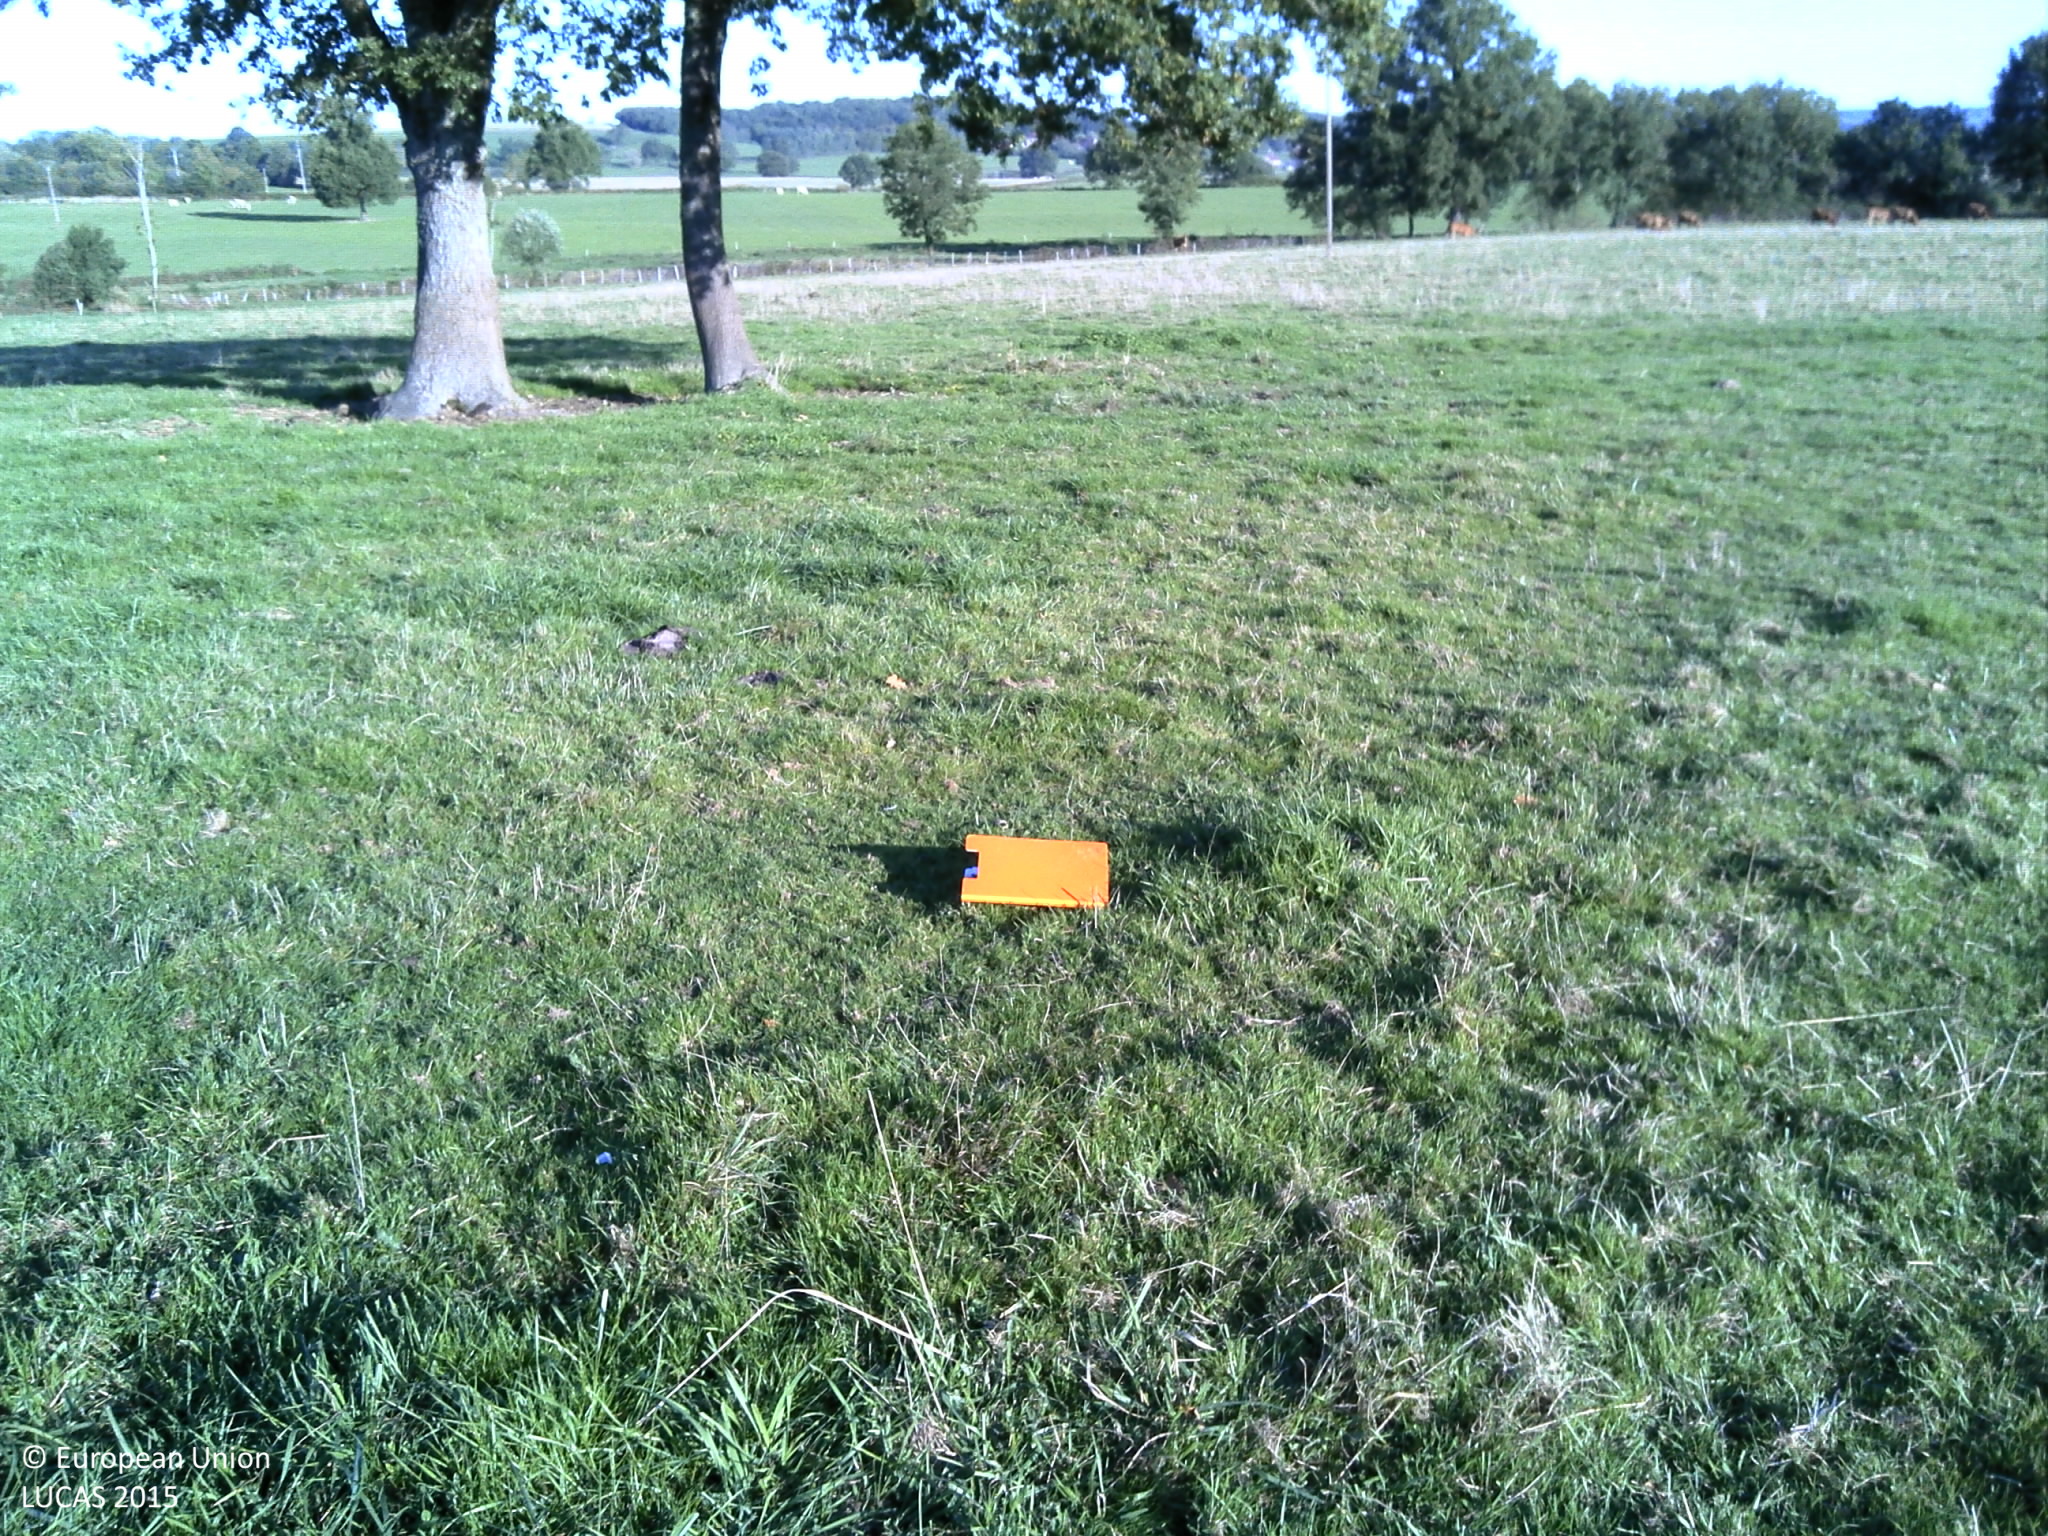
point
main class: Grassland
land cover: Grassland with sparse tree/shrub cover
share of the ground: > 75 %
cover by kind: herbaceous plants 95 %, broadleaved forest trees 5 %
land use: Agriculture (excluding fallow land and kitchen gardens)
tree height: > 5 m
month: September
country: FR
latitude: 46.9813
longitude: 4.4127
